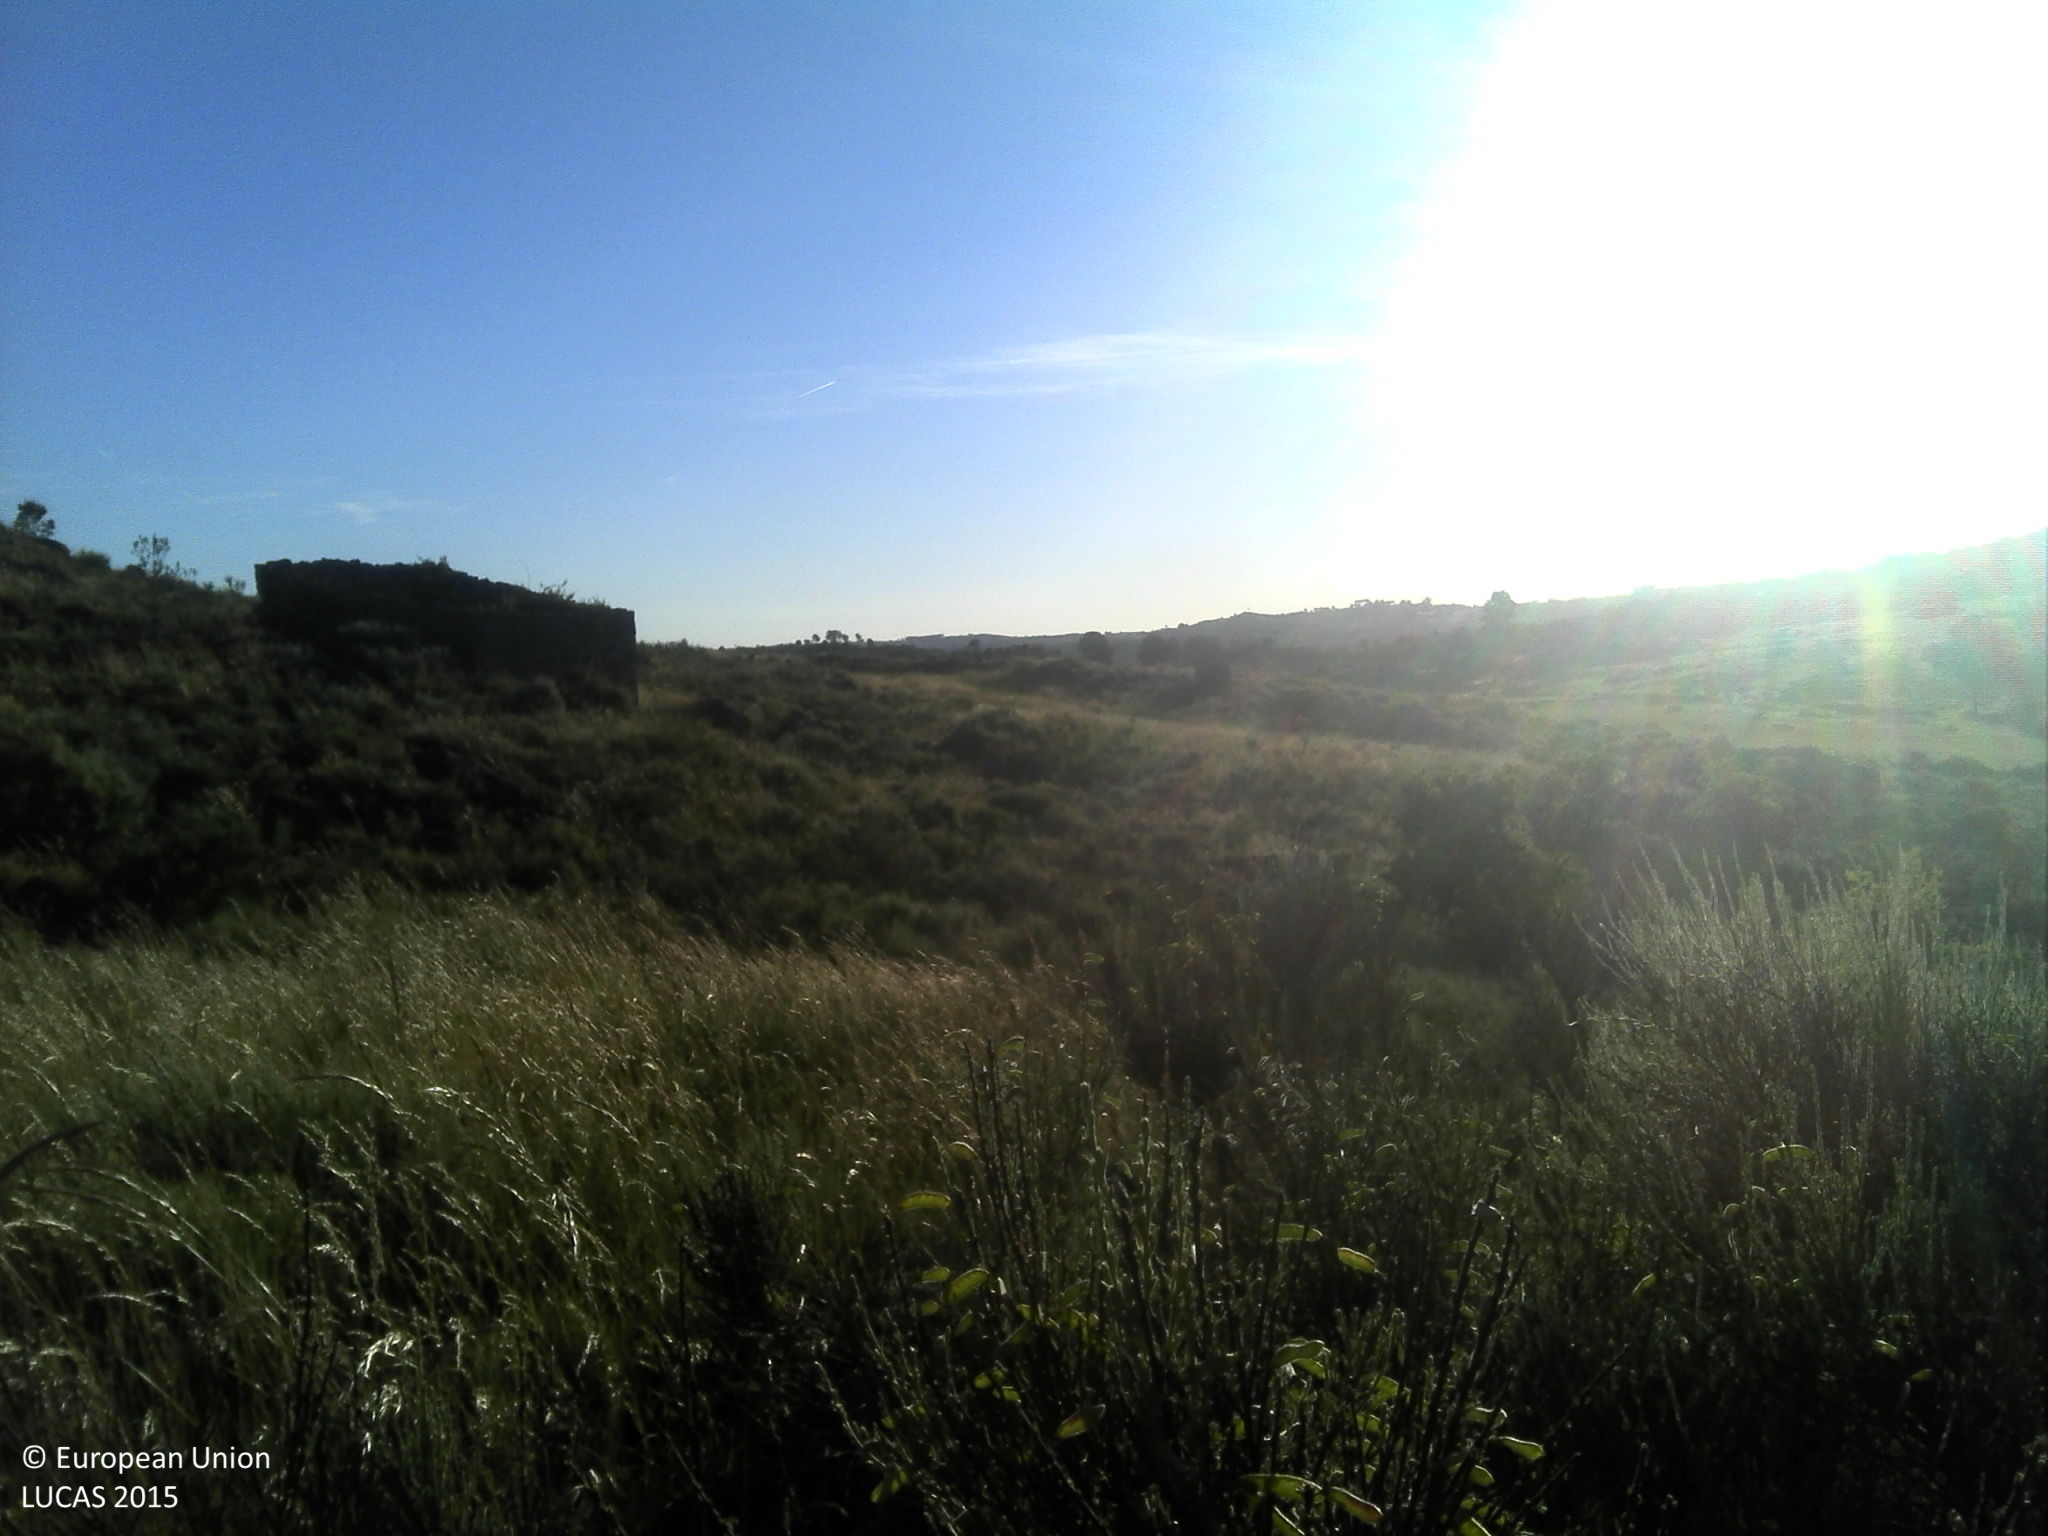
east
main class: Shrubland
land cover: Shrubland without tree cover
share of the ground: 50 - 75 %
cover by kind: shrubs 70 %, herbaceous plants 10 %, unconsolidated bare surface 10 %
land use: Agriculture (excluding fallow land and kitchen gardens)
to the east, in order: Shrubland without tree cover; Other bare soil; Shrubland without tree cover; Other bare soil; Spontaneously vegetated surfaces; Grass margins; Paved roads, cycling and walking lanes; Grass margins; Grassland with sparse tree/shrub cover
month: May
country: PT
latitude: 40.5790
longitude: -7.5142
